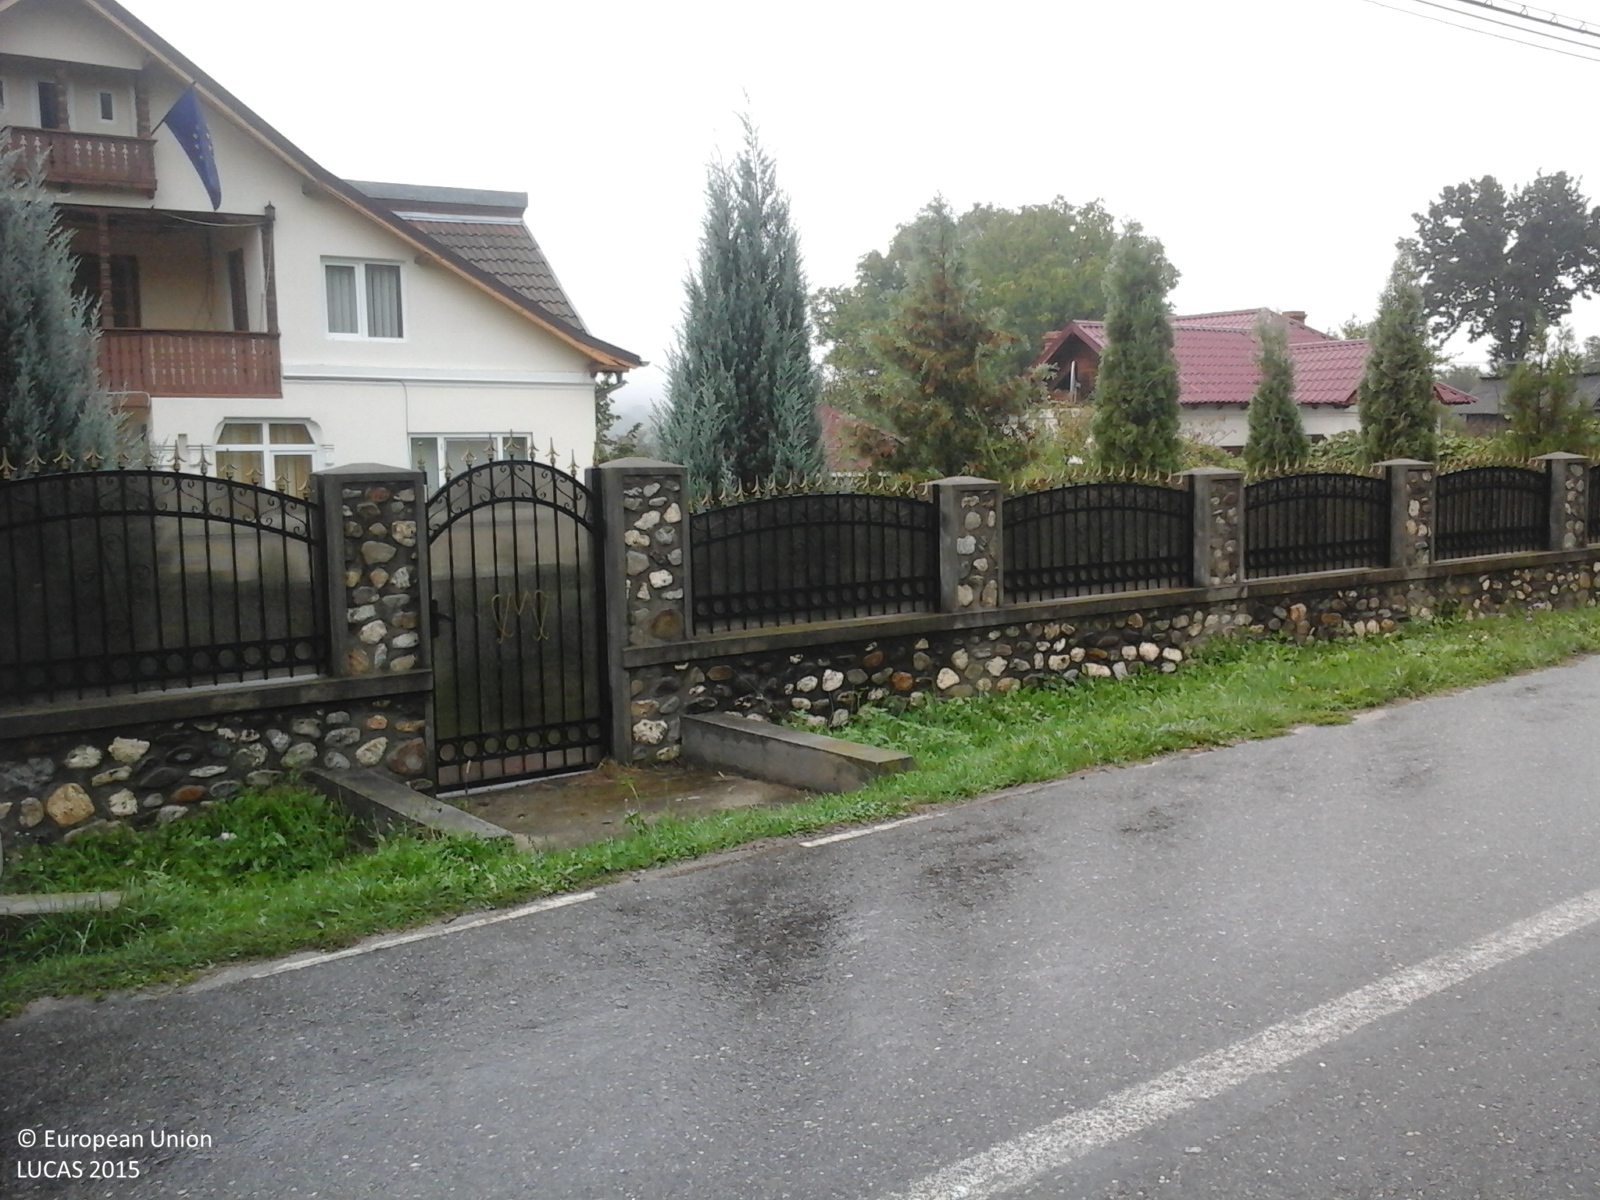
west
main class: Cropland
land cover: Apple fruit
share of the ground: 50 - 75 %
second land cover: Grassland without tree/shrub cover
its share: > 75 %
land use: Agriculture (excluding fallow land and kitchen gardens)
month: September
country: RO
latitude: 45.1129
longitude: 24.0109
